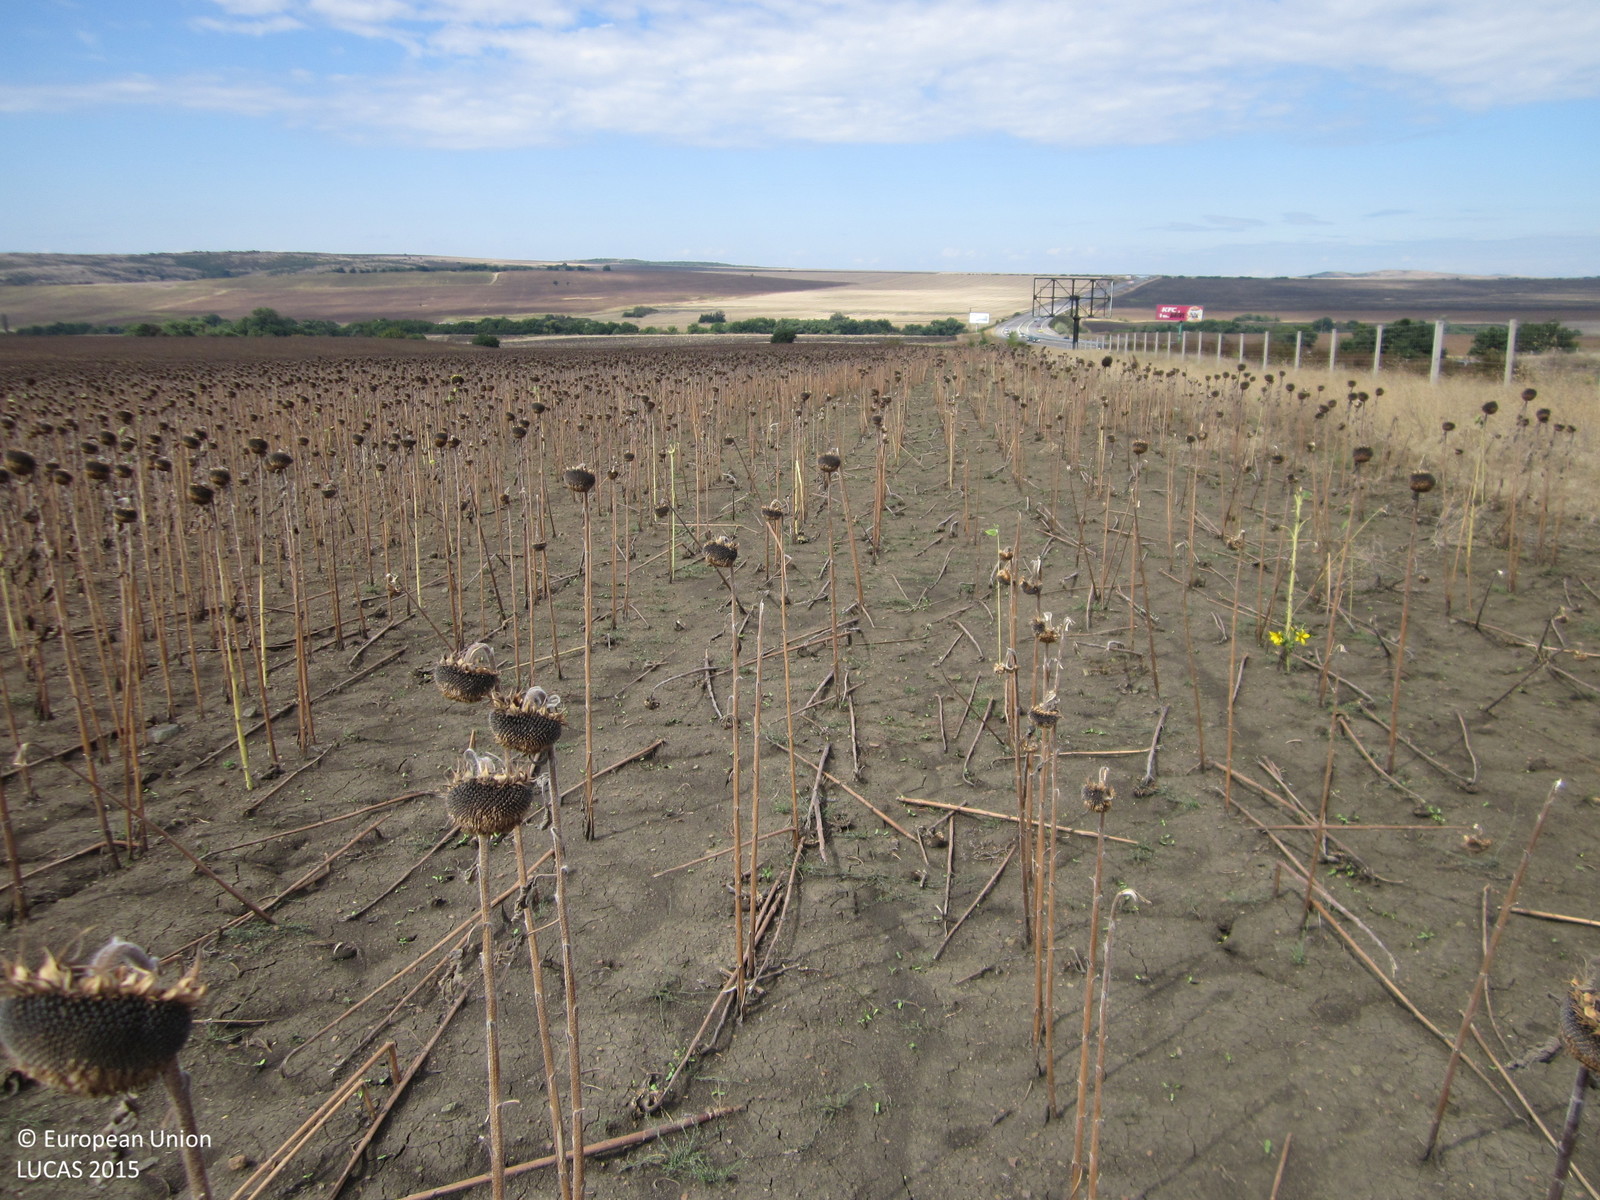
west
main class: Cropland
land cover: Sunflower
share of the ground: 50 - 75 %
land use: Agriculture (excluding fallow land and kitchen gardens)
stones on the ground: < 10 %
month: August
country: BG
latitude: 42.5857
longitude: 27.1068
